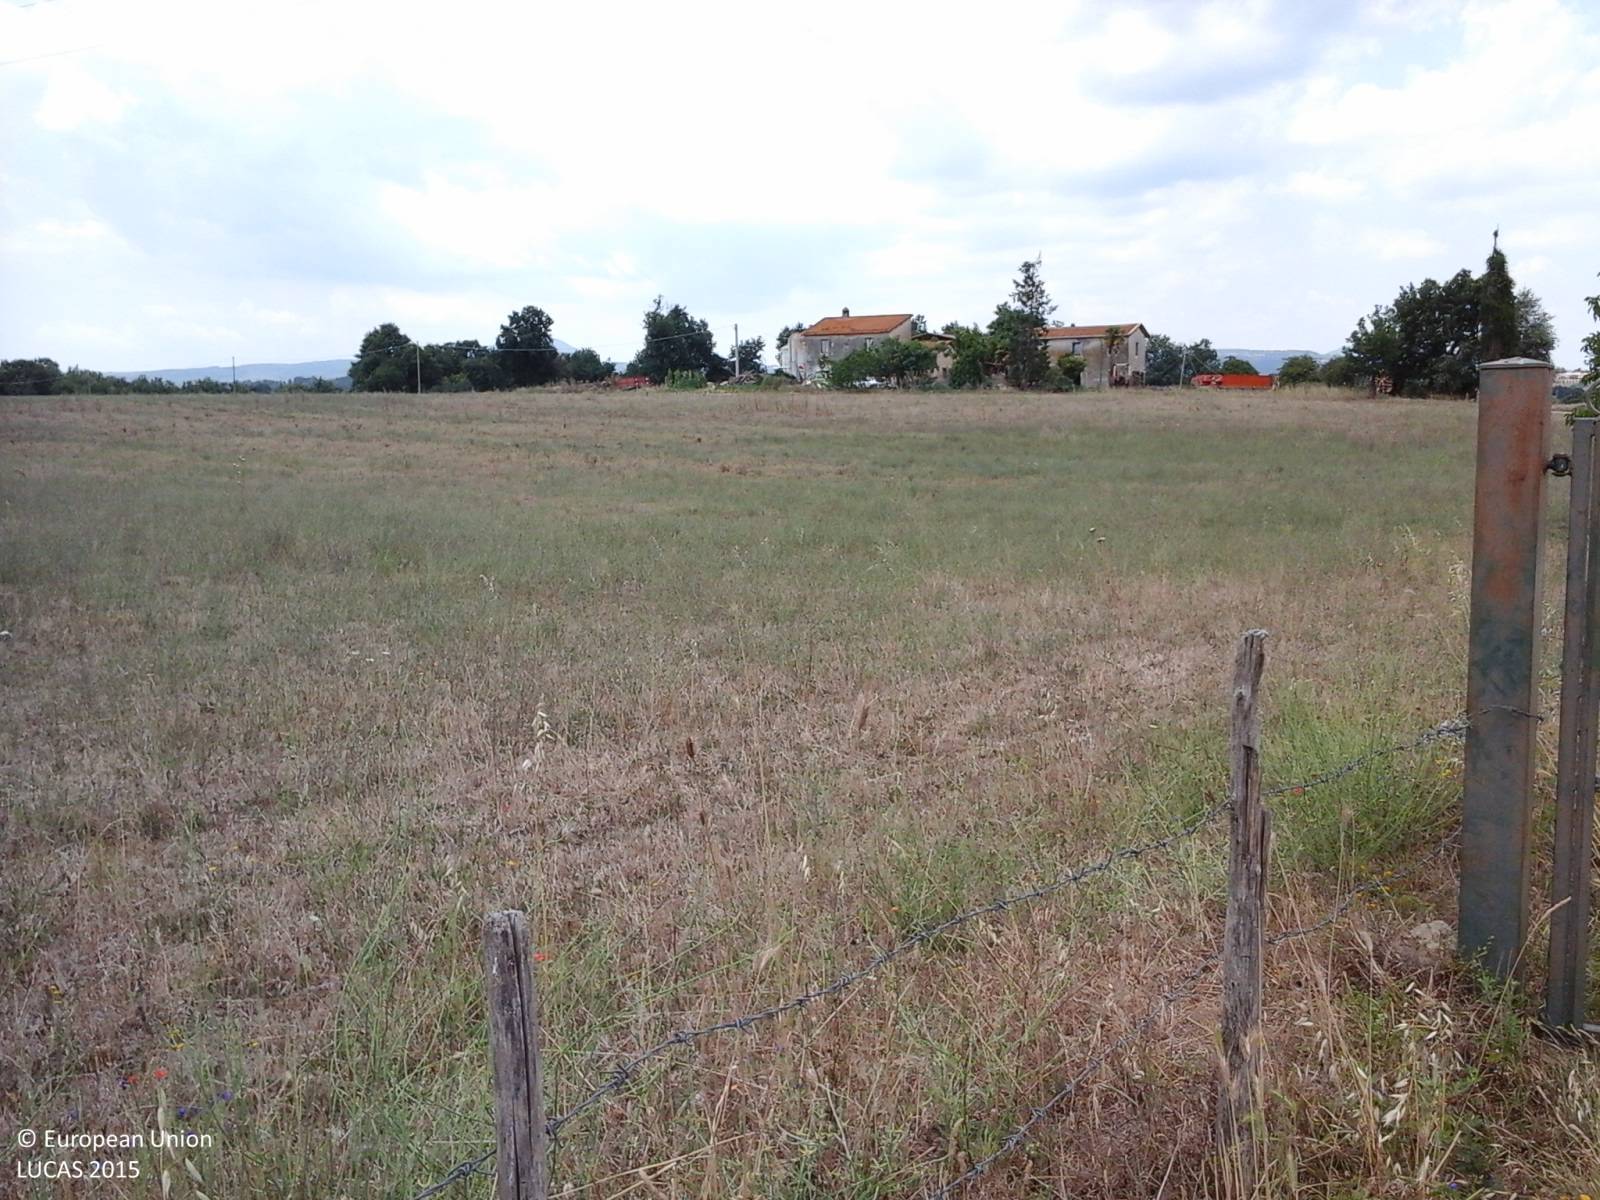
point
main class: Cropland
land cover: Temporary grasslands
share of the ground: > 75 %
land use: Agriculture (excluding fallow land and kitchen gardens)
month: June
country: IT
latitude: 42.2313
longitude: 12.2579
